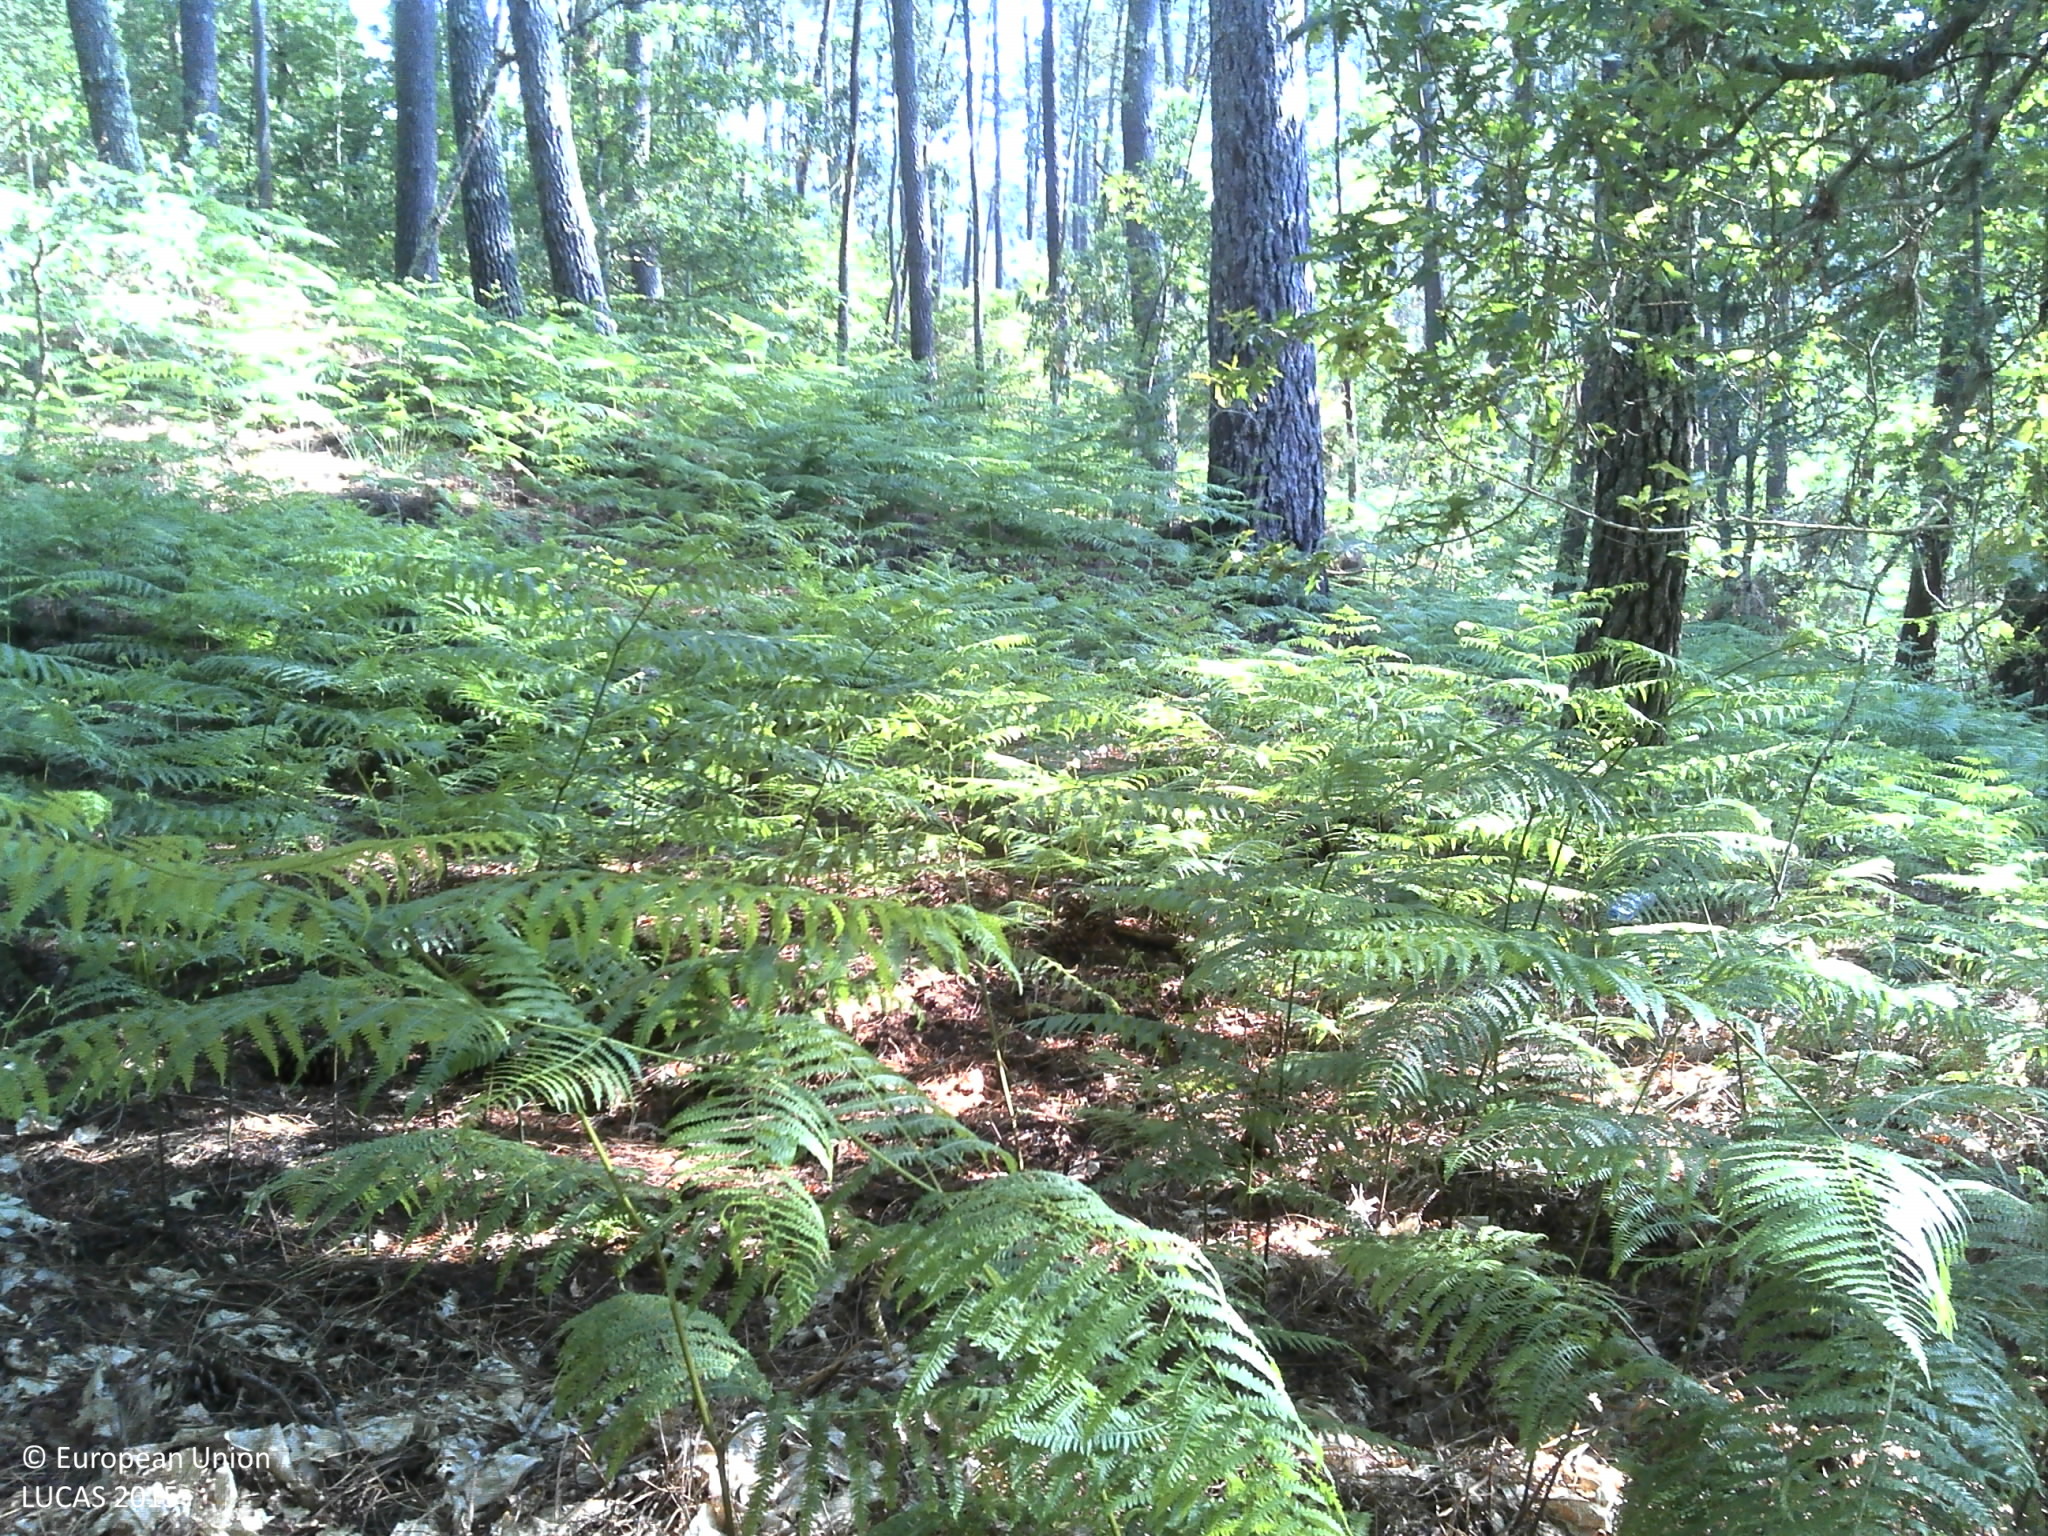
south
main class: Woodland
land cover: Broadleaved woodland
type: acidophilous oak and oak-birch forest
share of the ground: > 75 %
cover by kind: broadleaved forest trees 85 %, coniferous forest trees 5 %, herbaceous plants 5 %, unconsolidated bare surface 5 %
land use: Forestry
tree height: > 5 m
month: June
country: PT
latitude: 42.0864
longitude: -8.2549
